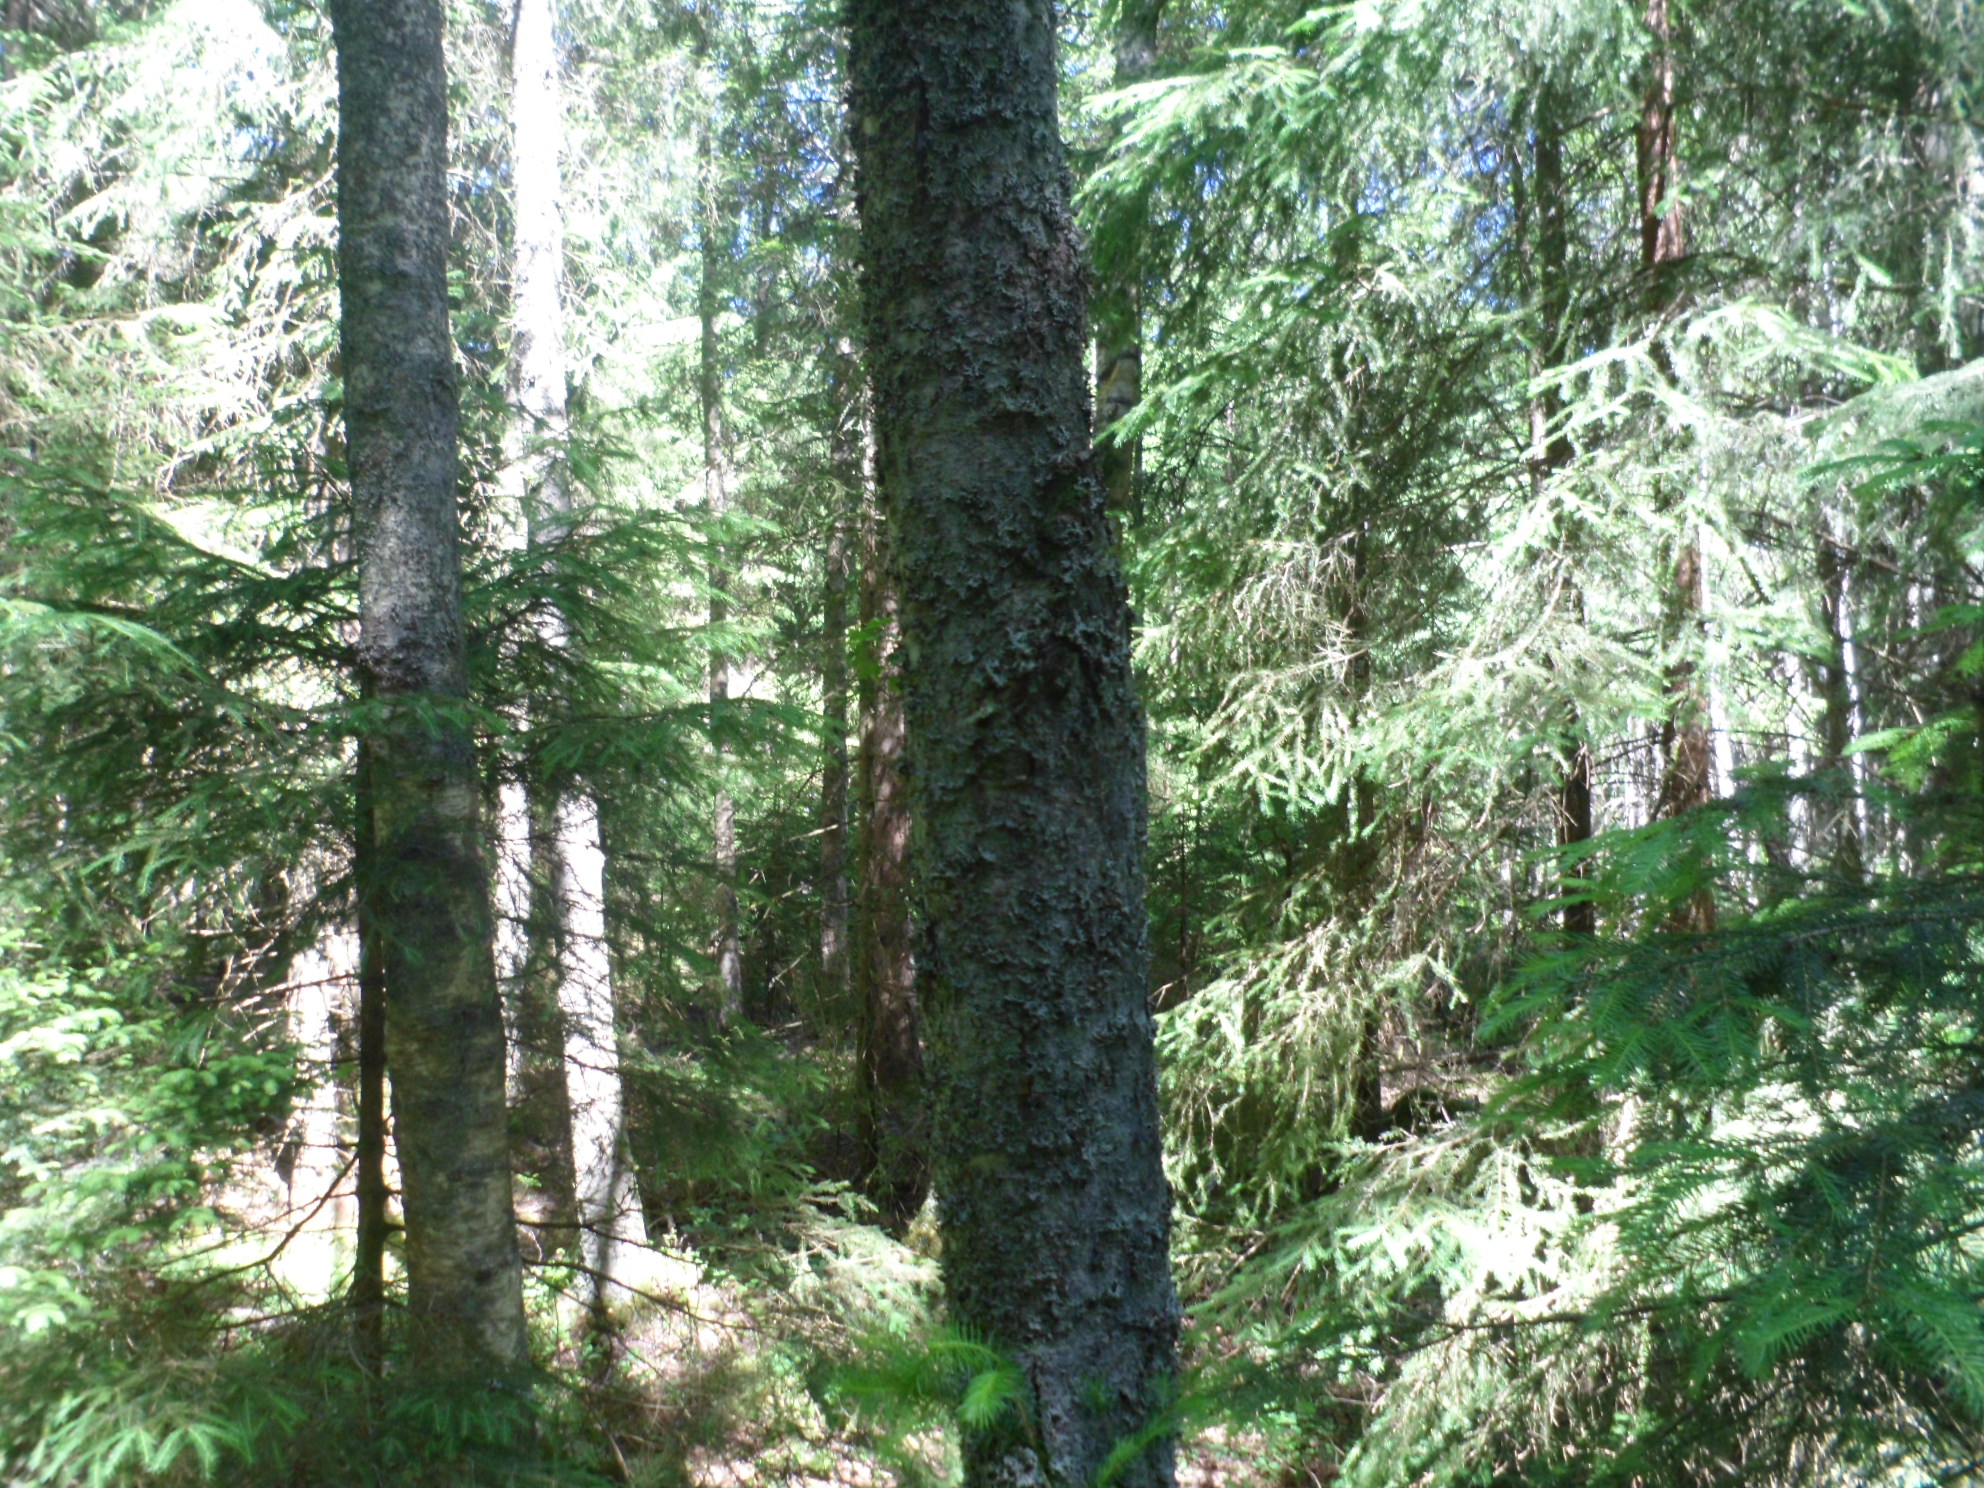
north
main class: Woodland
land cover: Spruce dominated mixed woodland
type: boreal forest
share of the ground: 50 - 75 %
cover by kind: coniferous forest trees 45 %, broadleaved forest trees 30 %, herbaceous plants 10 %, lichens and mosses 10 %, shrubs 5 %
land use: Forestry
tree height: > 5 m
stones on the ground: < 10 %
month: July
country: SE
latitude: 57.0814
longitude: 14.5006
